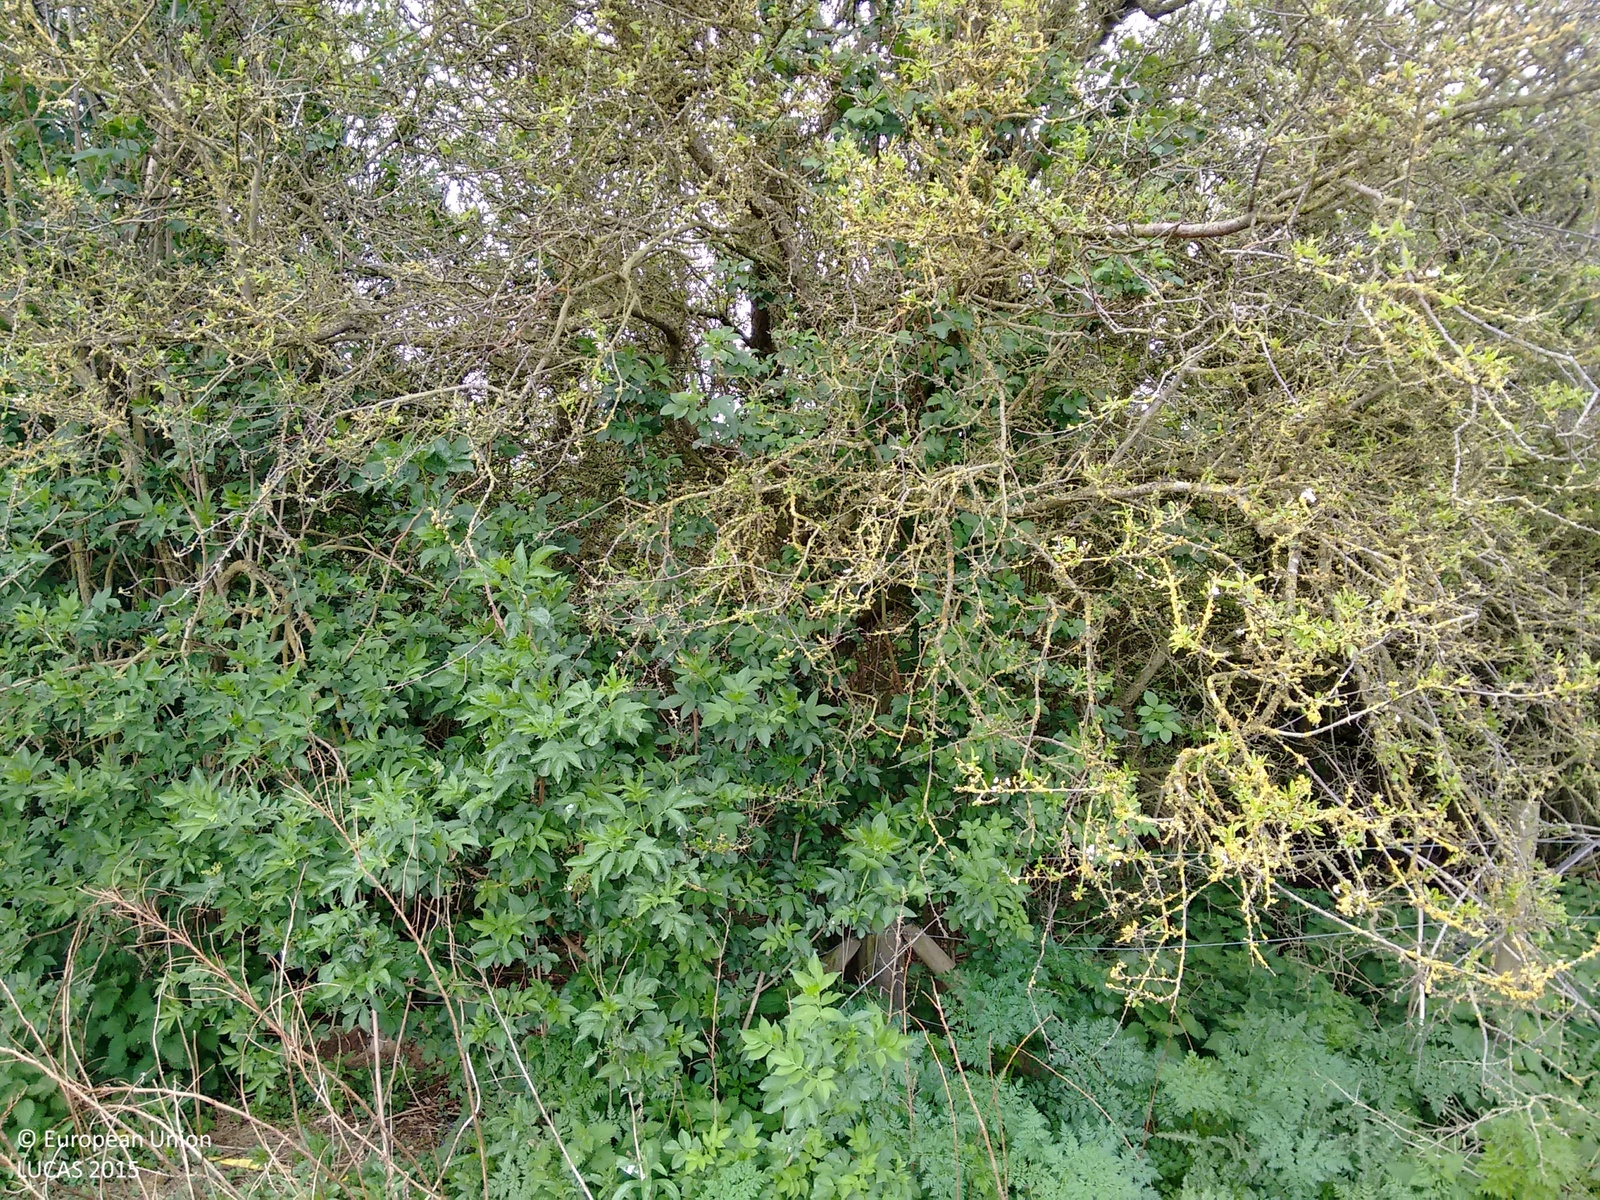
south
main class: Grassland
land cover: Grassland without tree/shrub cover
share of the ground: > 75 %
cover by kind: herbaceous plants 100 %
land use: Amenities, museums, leisure
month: May
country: GB
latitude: 53.9036
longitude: -0.3083
